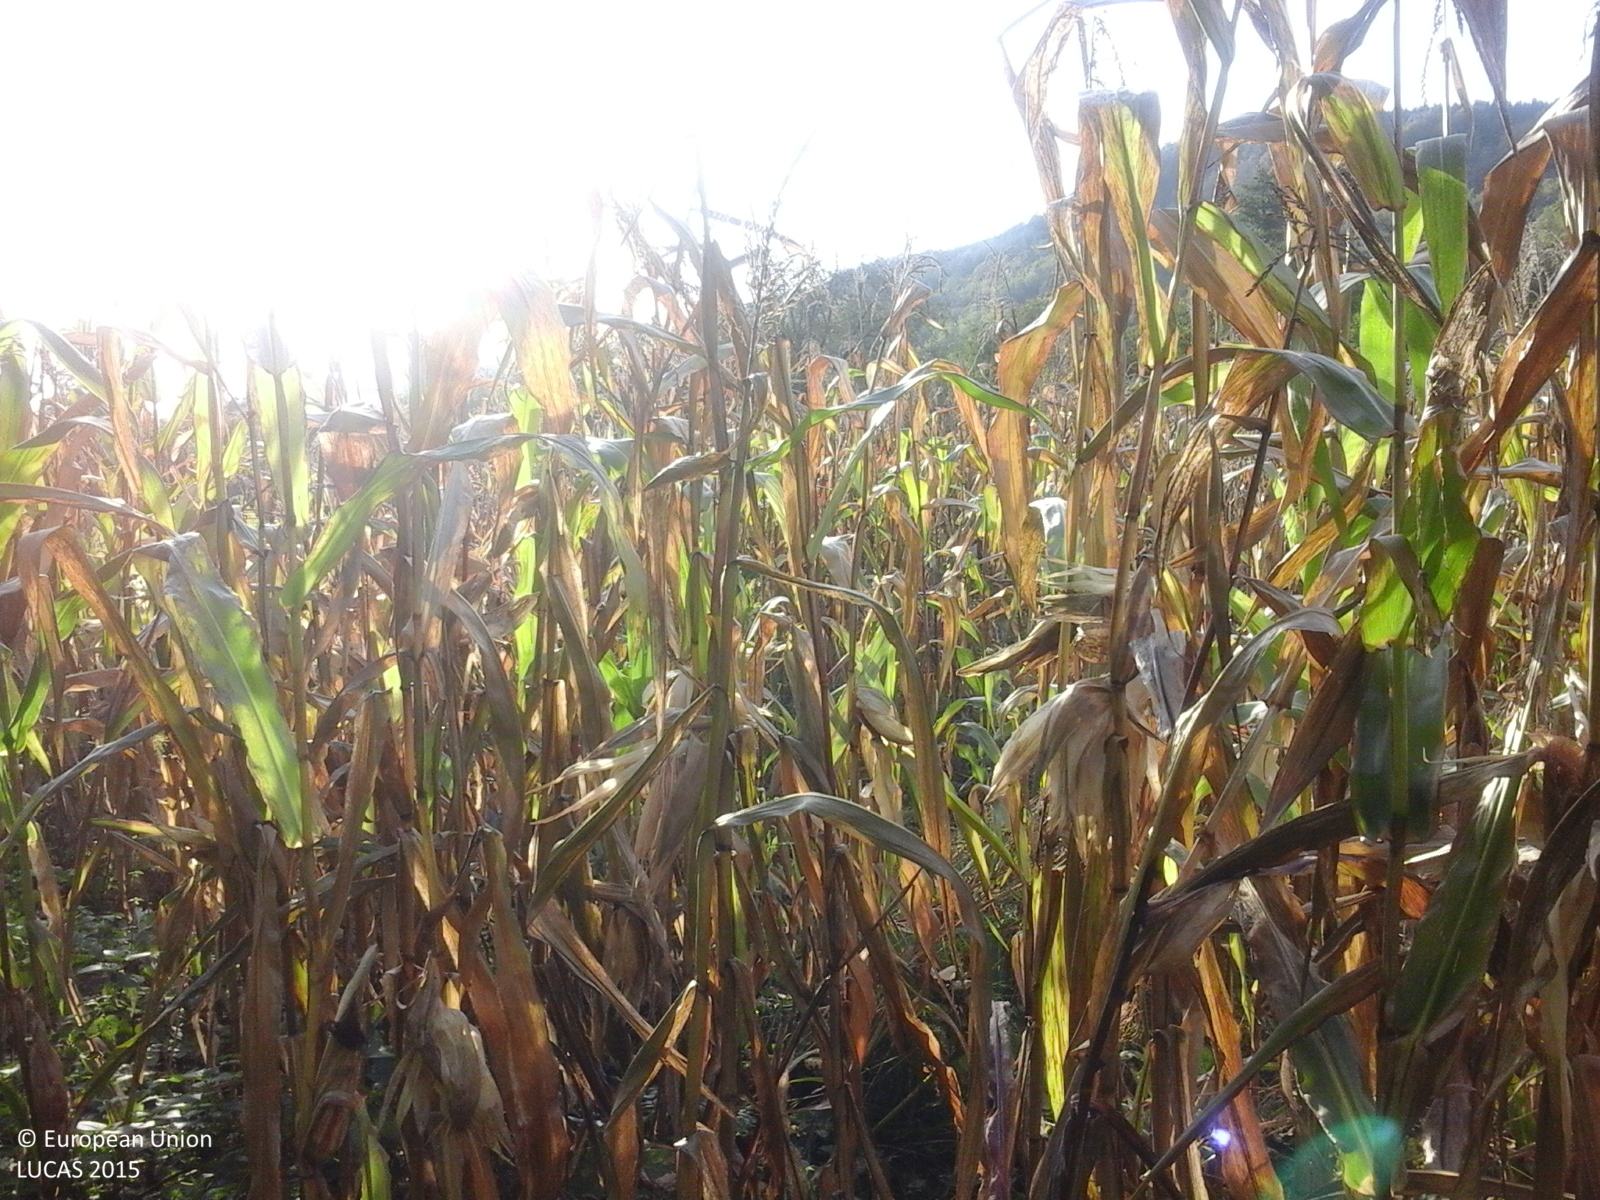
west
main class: Cropland
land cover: Maize
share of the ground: > 75 %
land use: Agriculture (excluding fallow land and kitchen gardens)
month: October
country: RO
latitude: 46.5769
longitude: 24.9328
